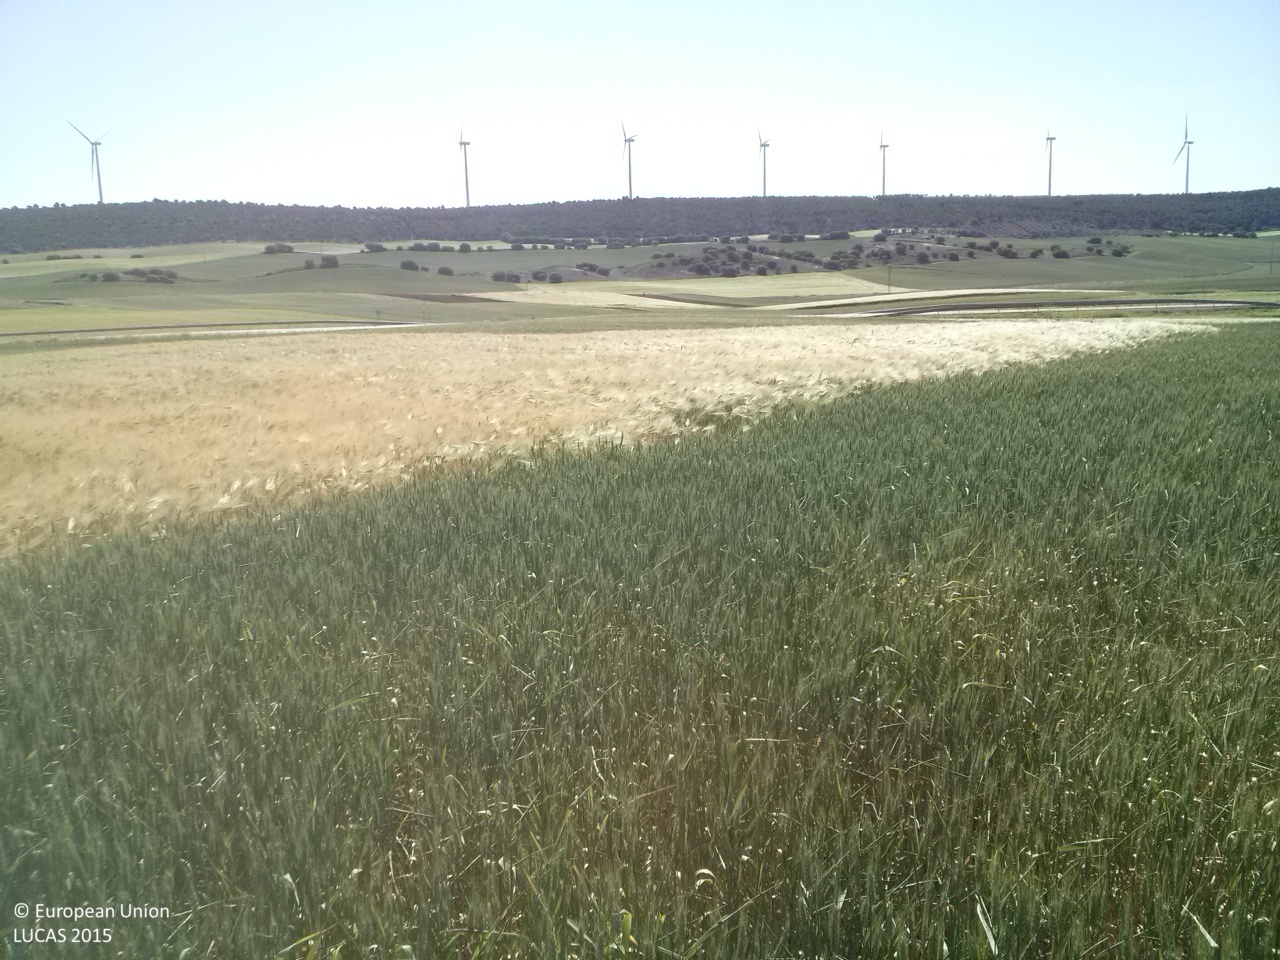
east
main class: Cropland
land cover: Common wheat
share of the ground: > 75 %
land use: Agriculture (excluding fallow land and kitchen gardens)
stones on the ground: < 10 %
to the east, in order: Common wheat; Barley; Common wheat; Grass margins; Paved roads, cycling and walking lanes; Grass margins; Barley; Common wheat
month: May
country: ES
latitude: 40.0132
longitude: -2.7796
